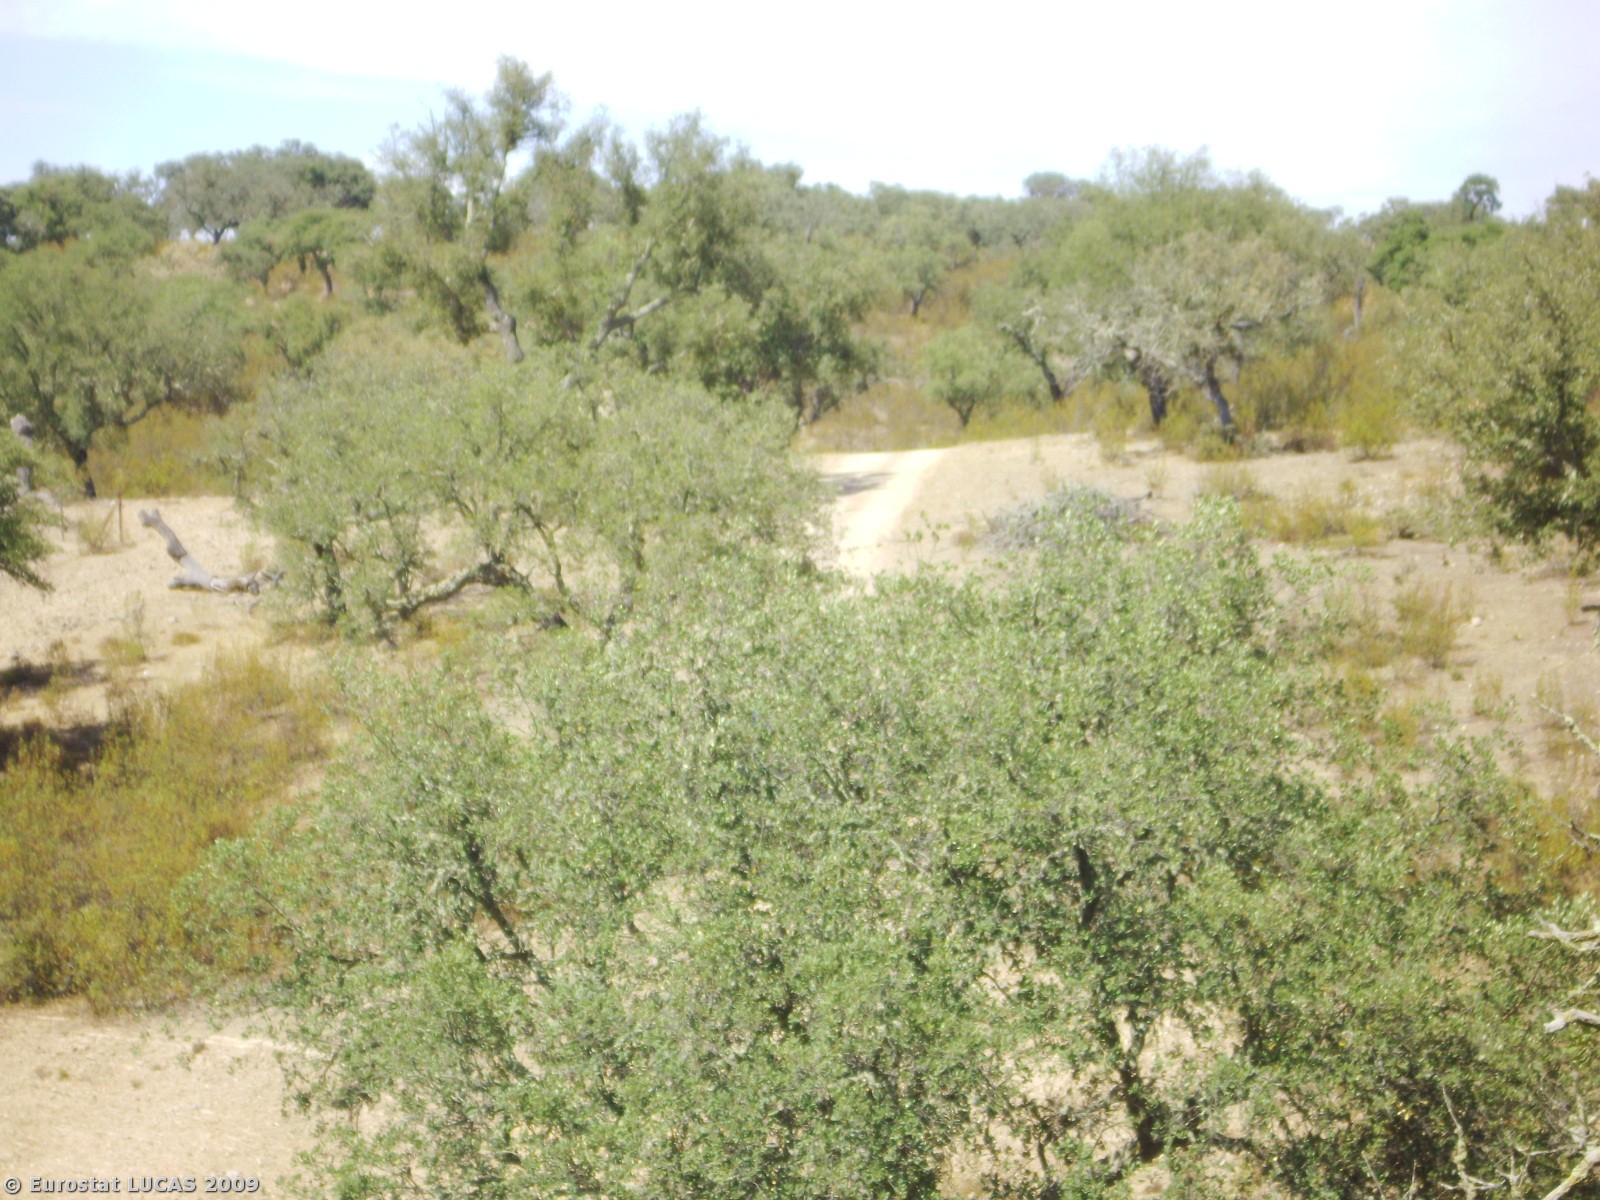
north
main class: Woodland
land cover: Broadleaved woodland
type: broadleaved evergreen forest
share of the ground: 50 - 75 %
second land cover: Shrubland with sparse tree cover
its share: 50 - 75 %
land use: Forestry
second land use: Unused
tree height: > 5 m
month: August
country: PT
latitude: 38.0668
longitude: -7.1211
